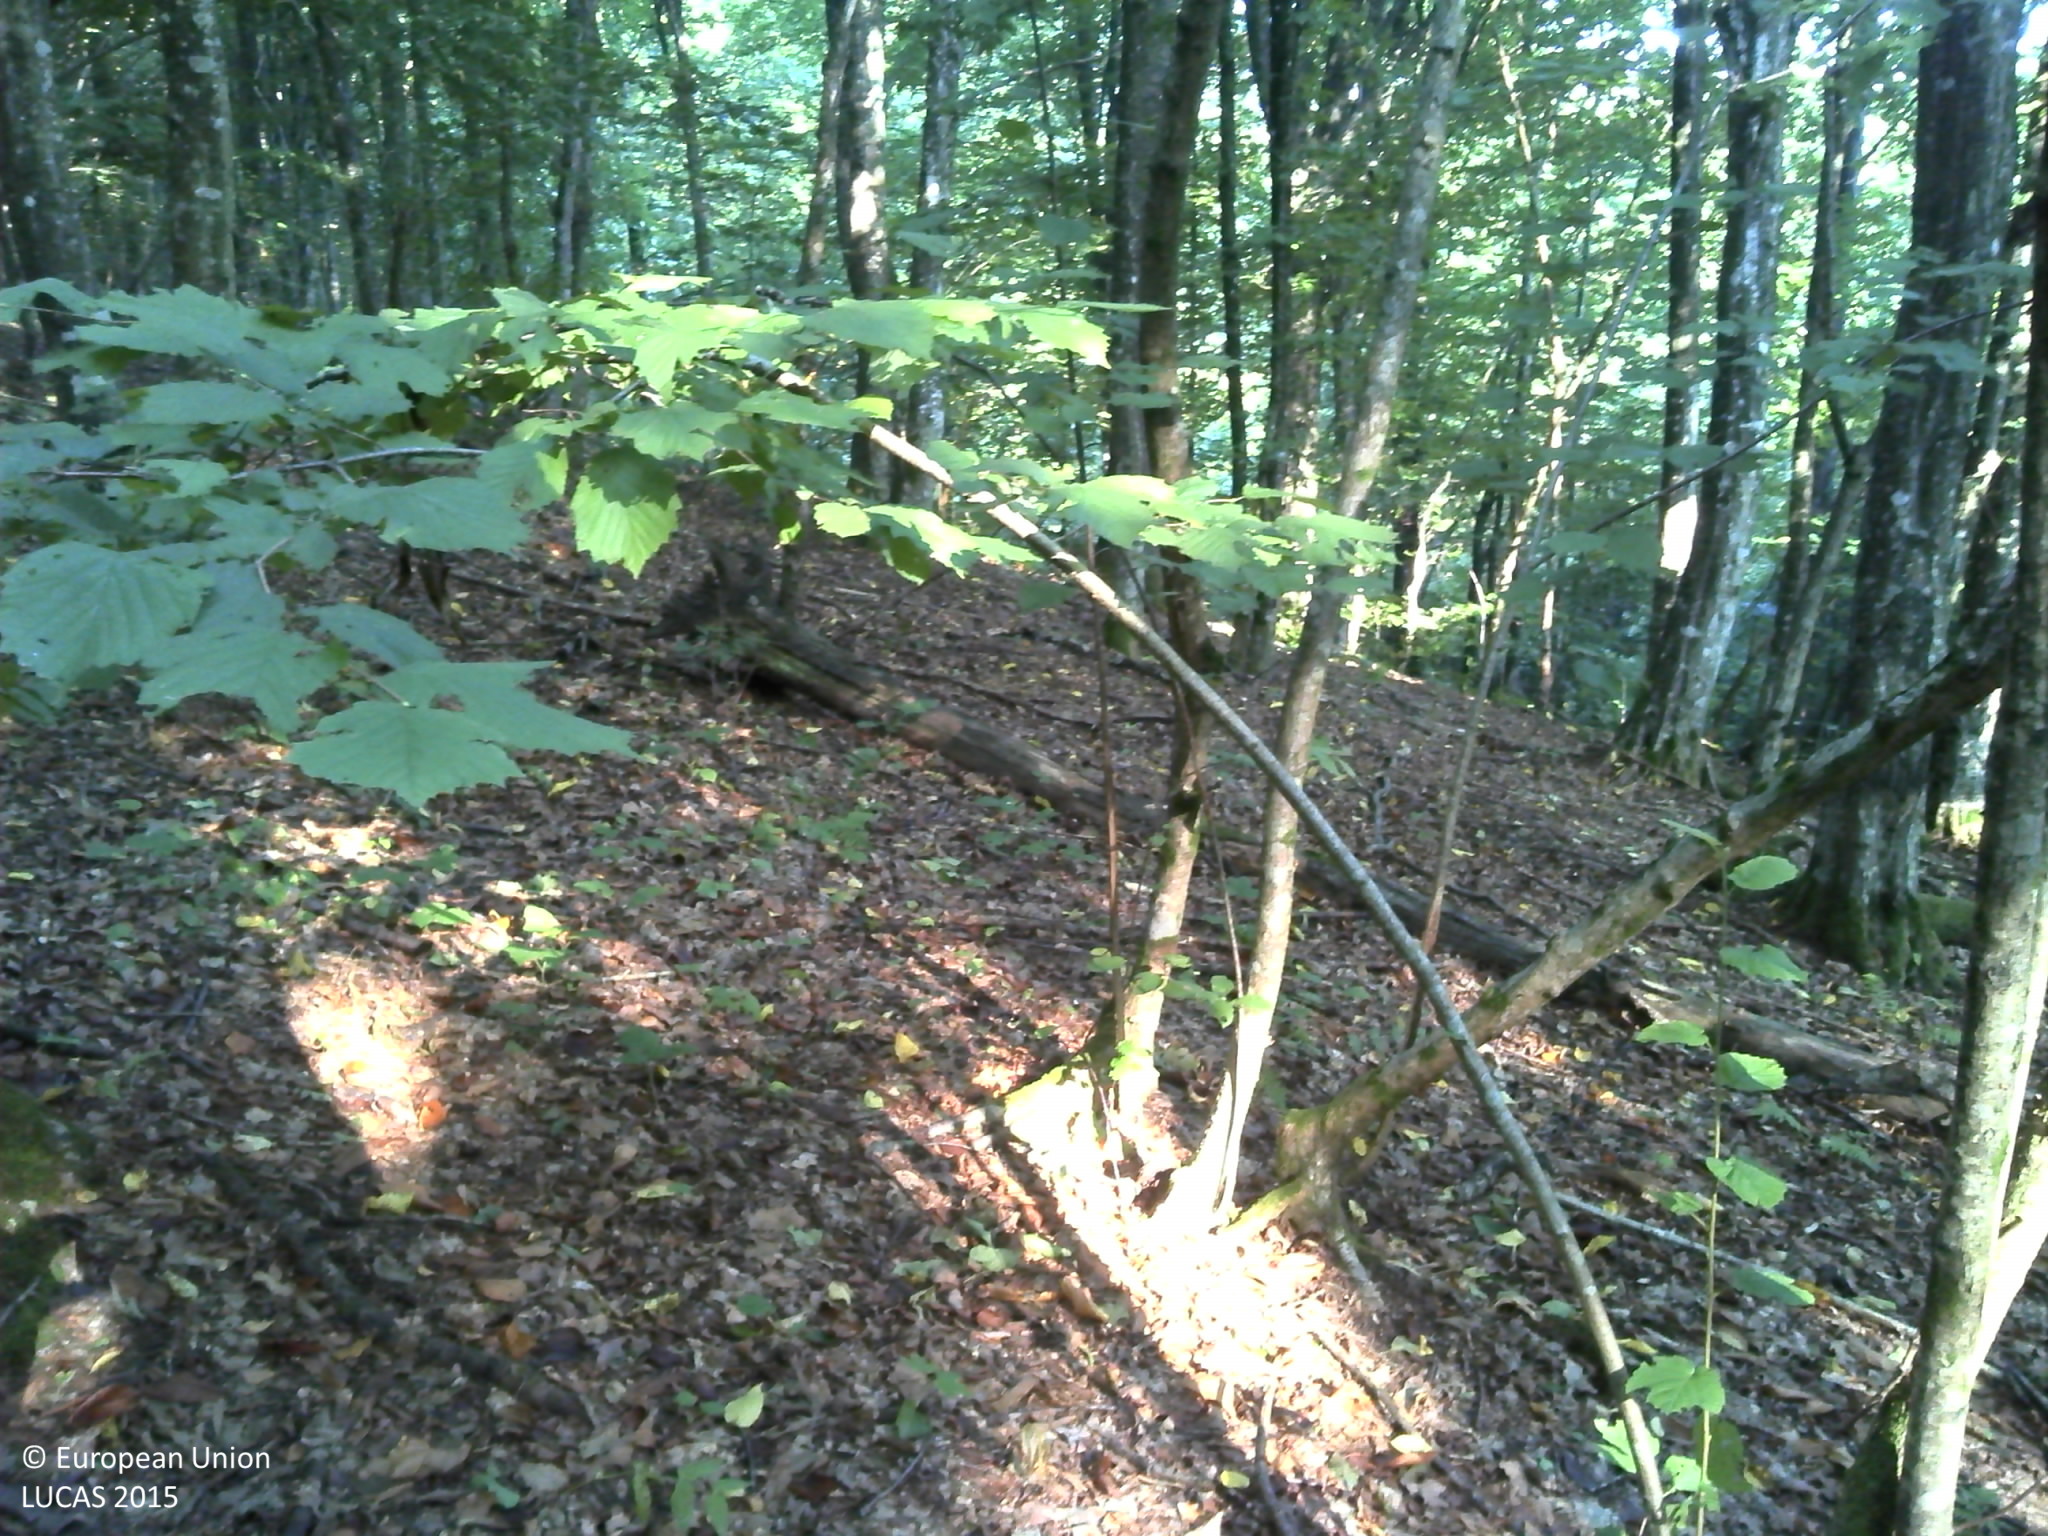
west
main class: Woodland
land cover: Broadleaved woodland
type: beech forest
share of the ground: > 75 %
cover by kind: broadleaved forest trees 100 %
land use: Forestry
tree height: > 5 m
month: August
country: HR
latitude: 45.3440
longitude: 16.1356
